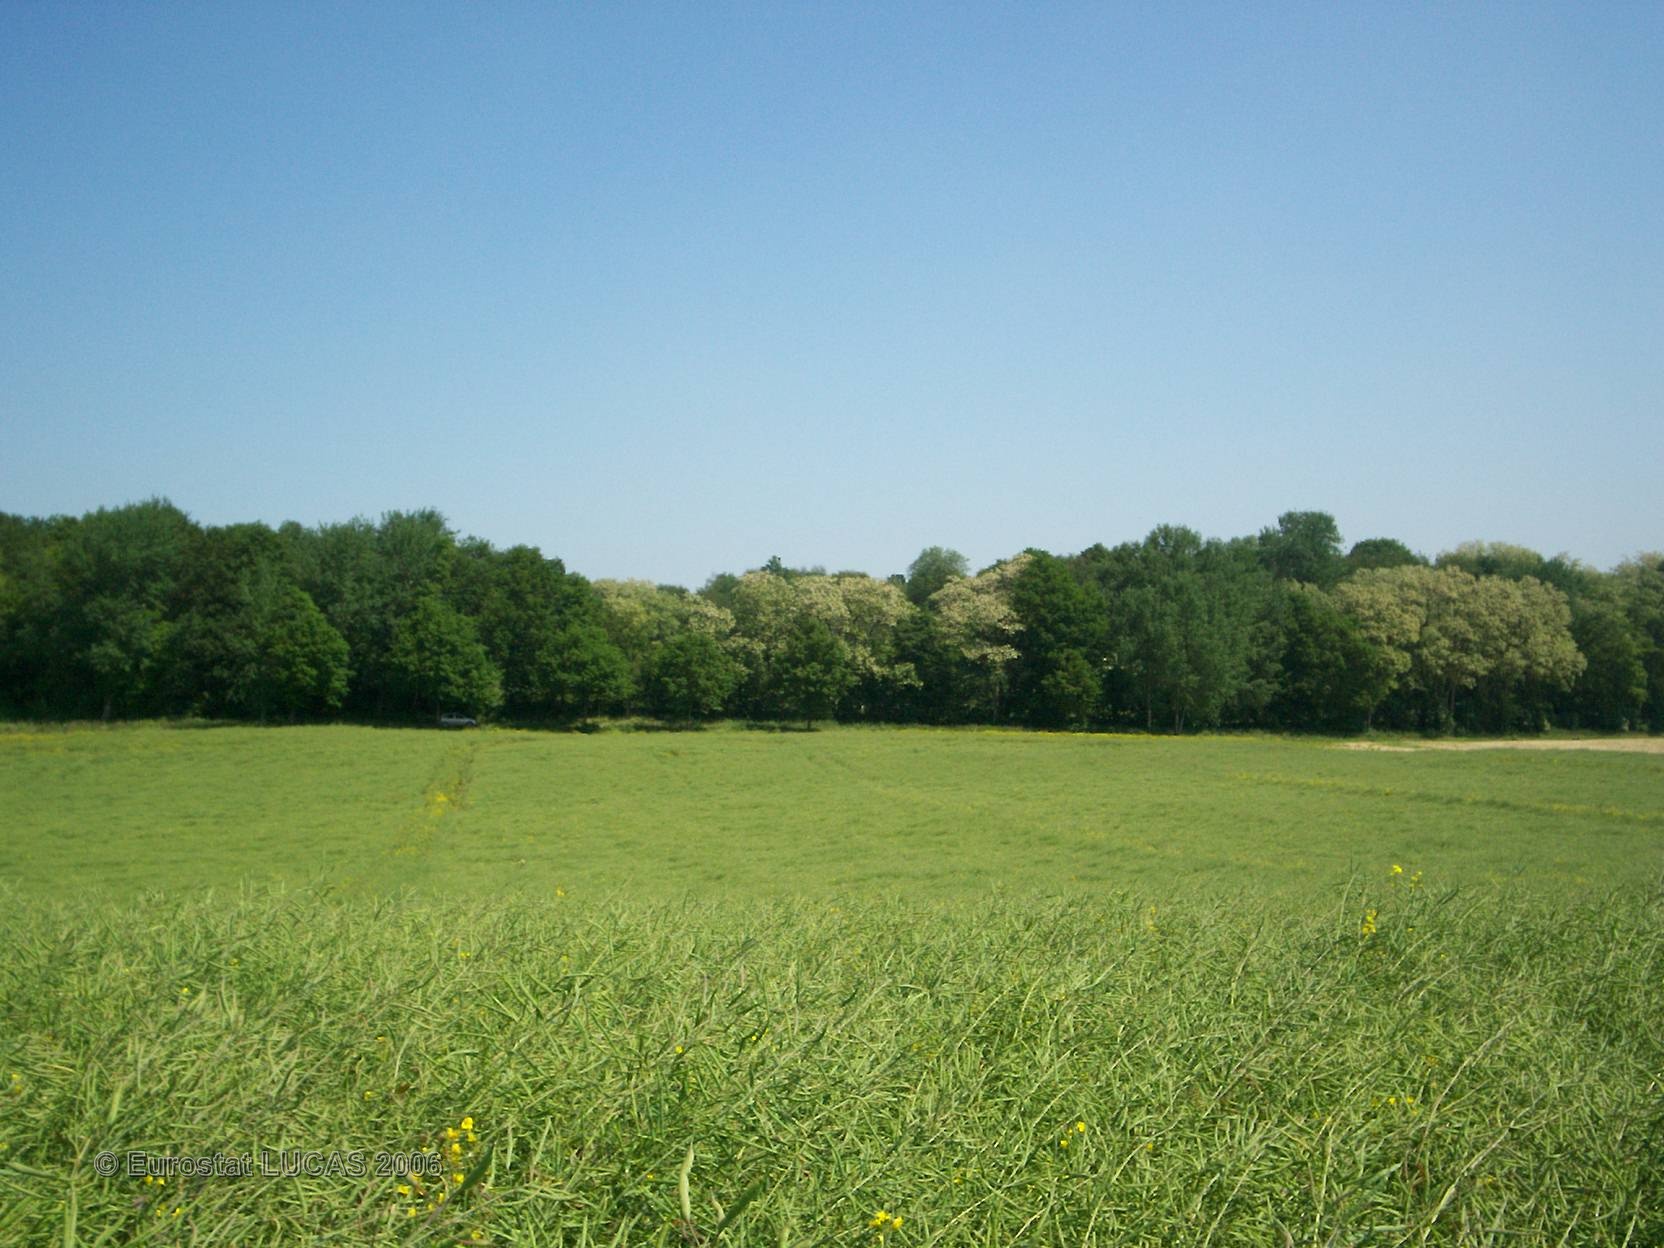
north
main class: Cropland
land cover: Rape and turnip rape
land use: Agriculture (excluding fallow land and kitchen gardens)
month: June
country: FR
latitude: 49.5191
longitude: 2.7372
